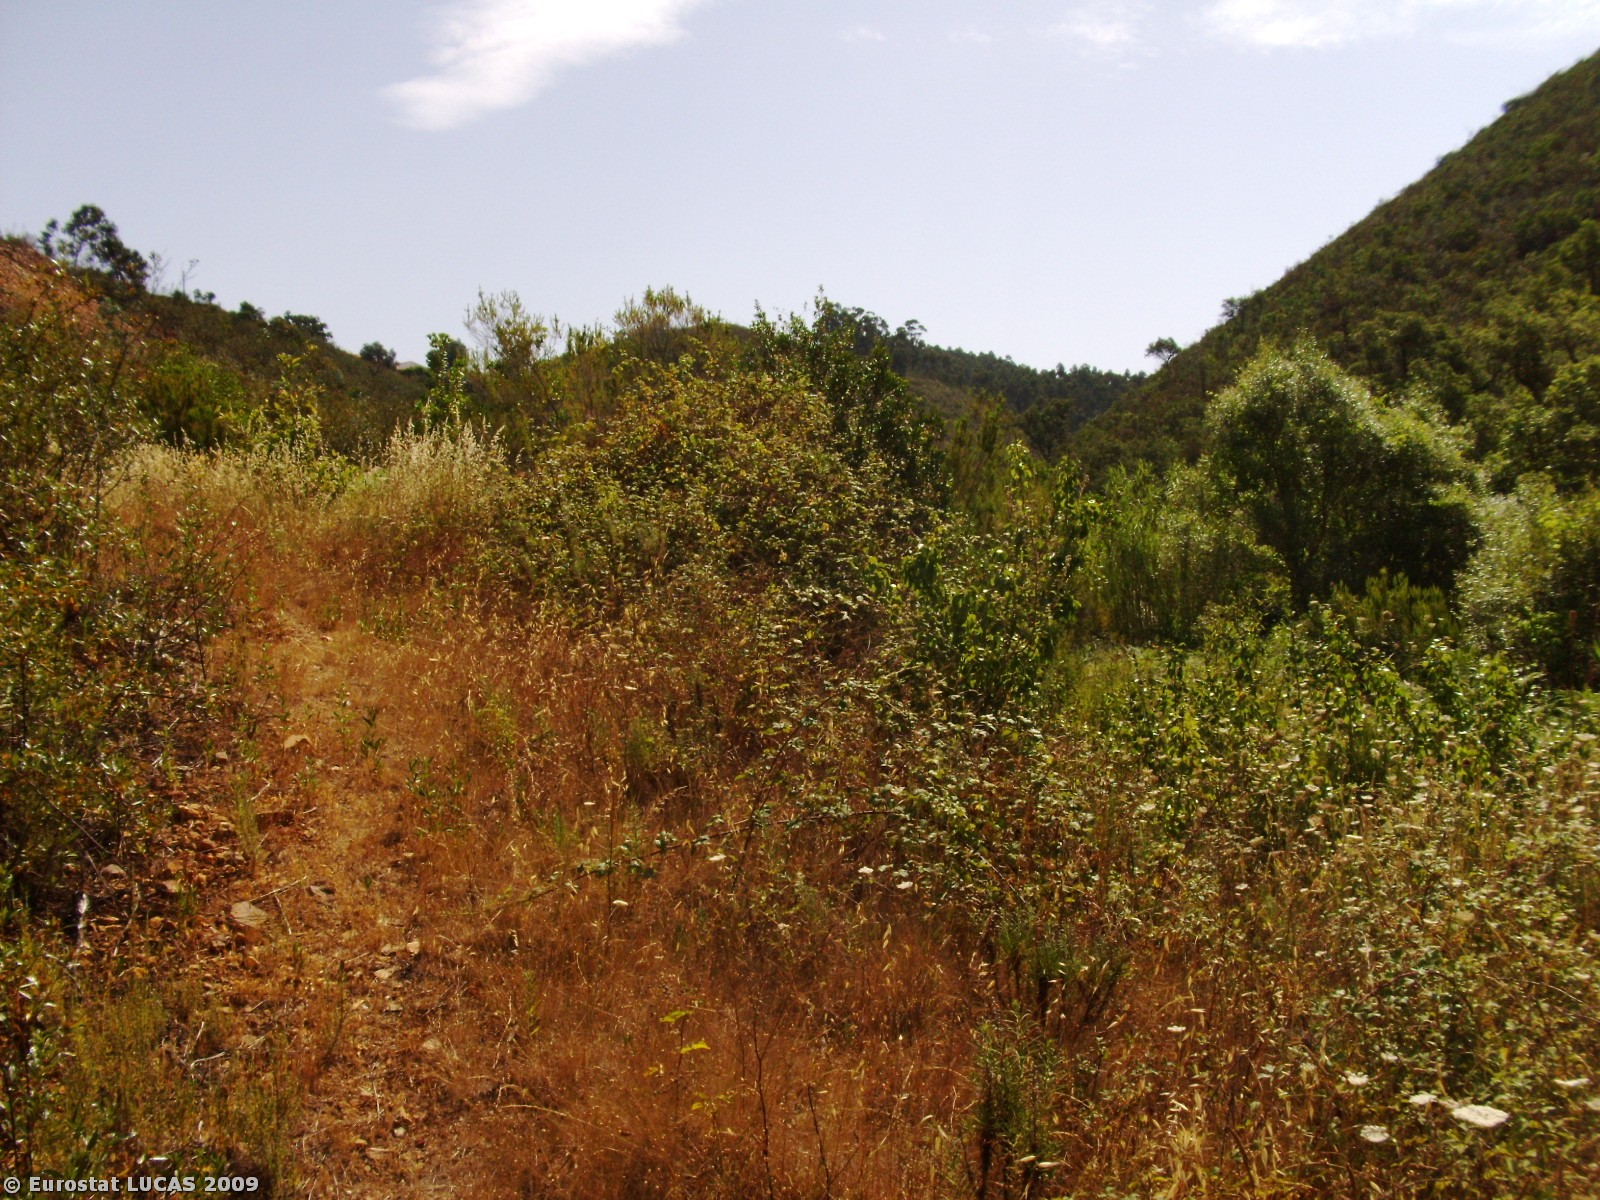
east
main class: Shrubland
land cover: Shrubland with sparse tree cover
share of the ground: > 75 %
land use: Unused
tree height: > 5 m
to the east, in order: Shrubland with sparse tree cover
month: June
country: PT
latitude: 37.3499
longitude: -8.7411
